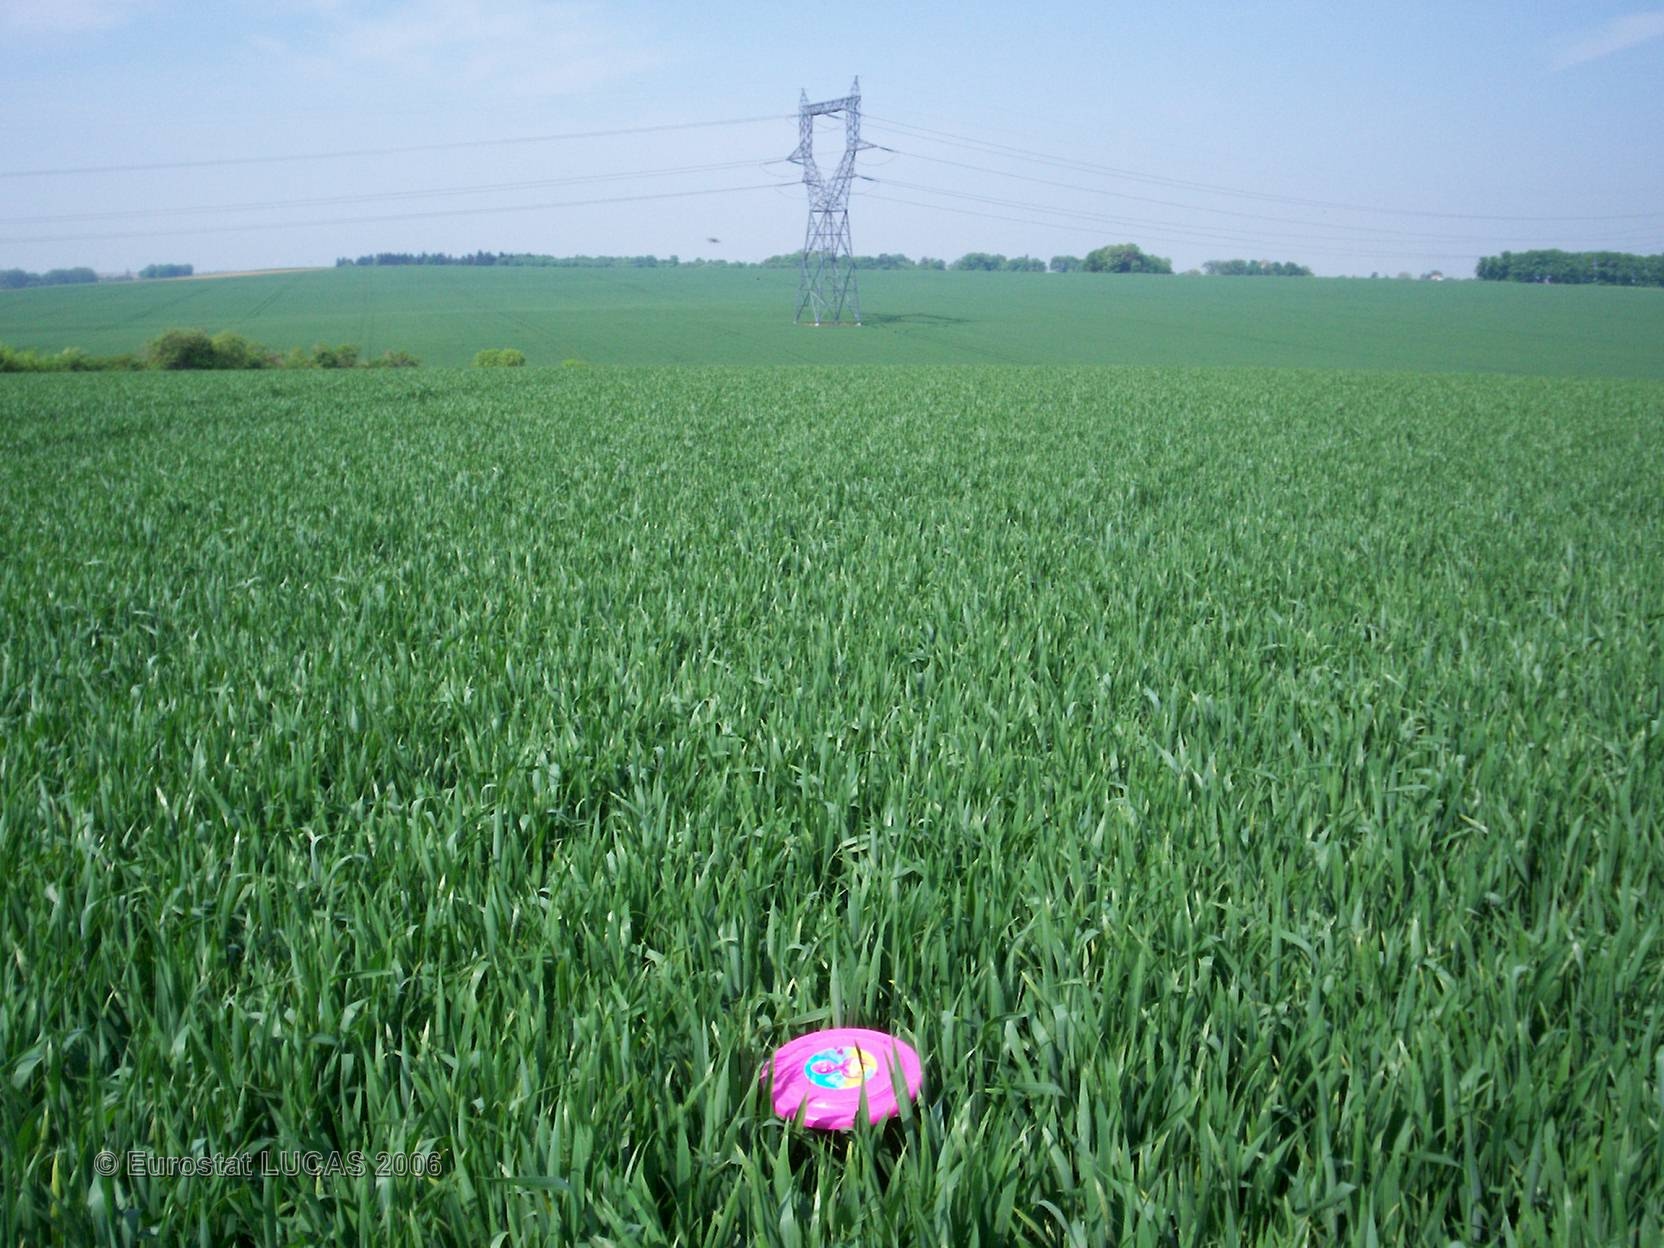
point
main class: Cropland
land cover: Common wheat
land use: Agriculture (excluding fallow land and kitchen gardens)
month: May
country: FR
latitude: 49.0130
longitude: 2.7297
